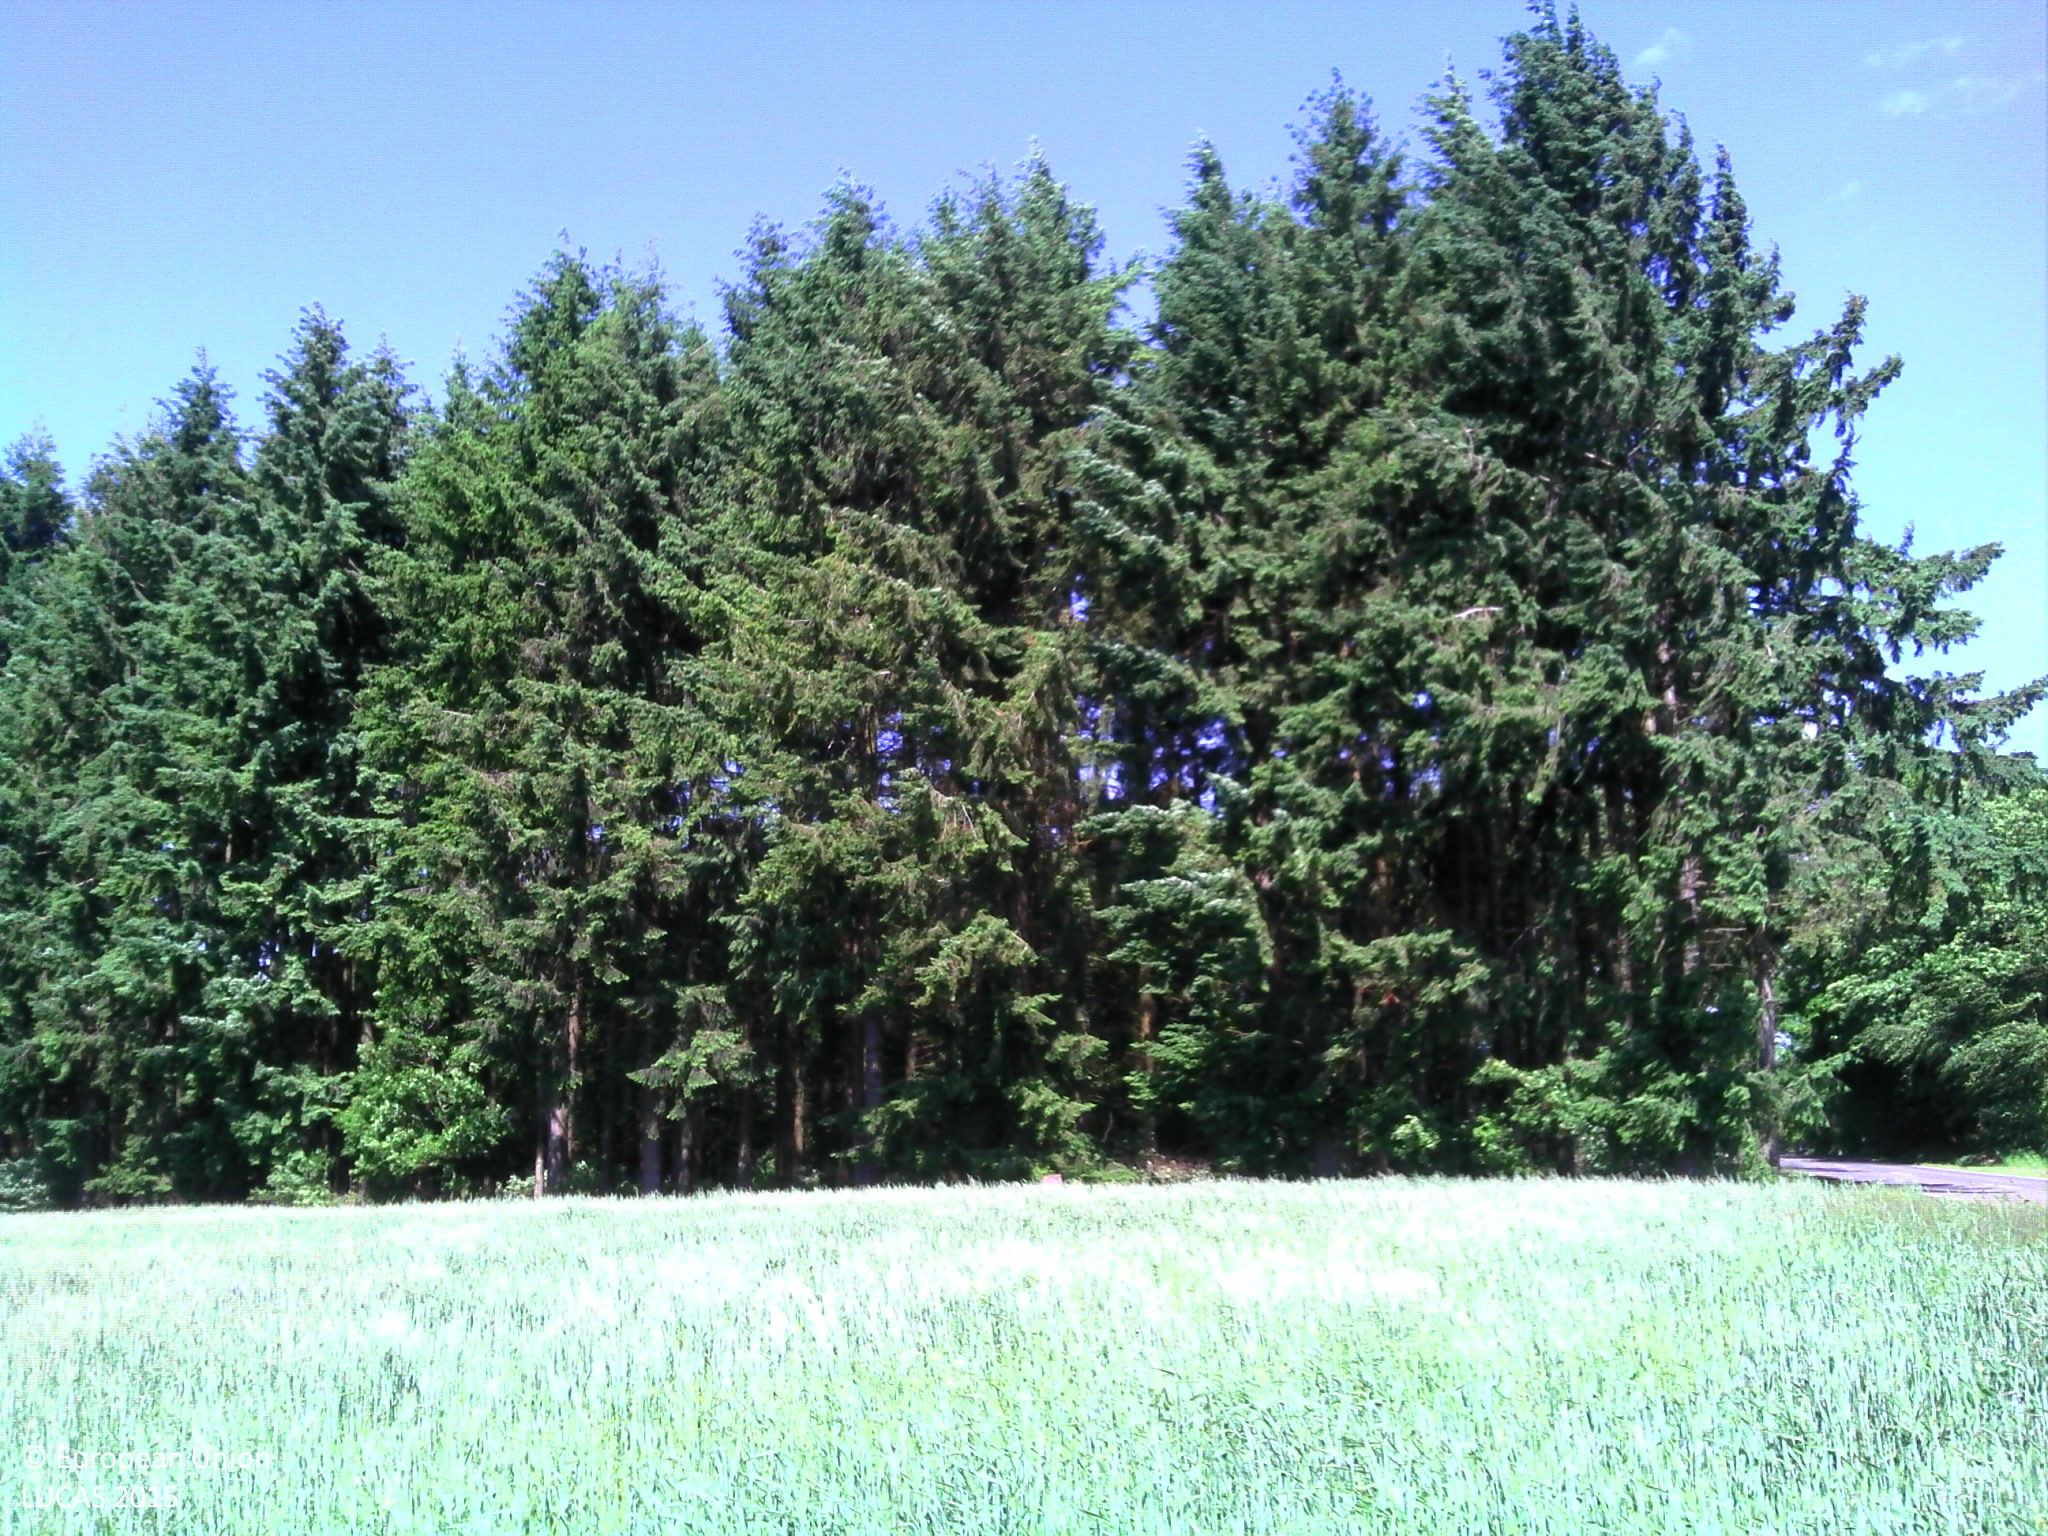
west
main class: Cropland
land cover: Common wheat
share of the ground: > 75 %
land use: Agriculture (excluding fallow land and kitchen gardens)
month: June
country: LU
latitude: 49.9091
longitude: 5.8075
